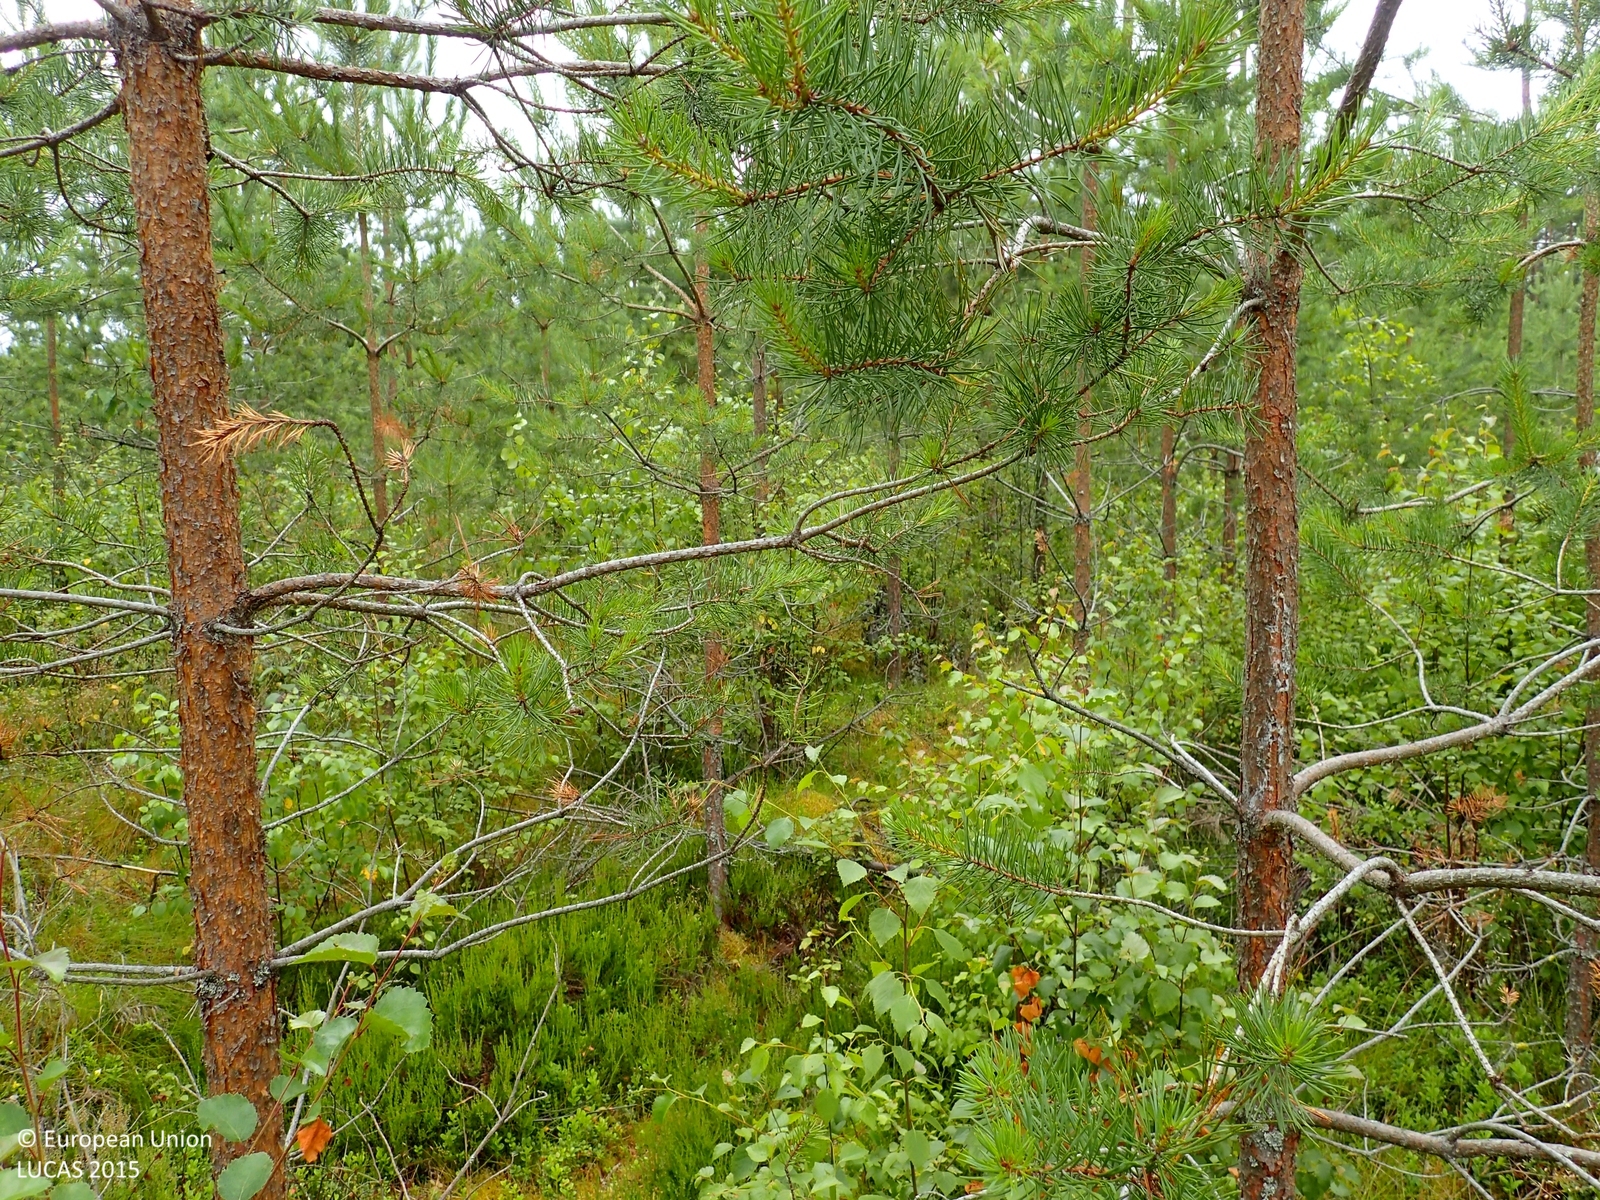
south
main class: Woodland
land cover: Pine dominated mixed woodland
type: boreal forest
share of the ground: > 75 %
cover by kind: coniferous forest trees 55 %, shrubs 25 %, broadleaved forest trees 20 %
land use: Forestry
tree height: < 5 m
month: July
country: FI
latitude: 62.8810
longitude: 23.2981
